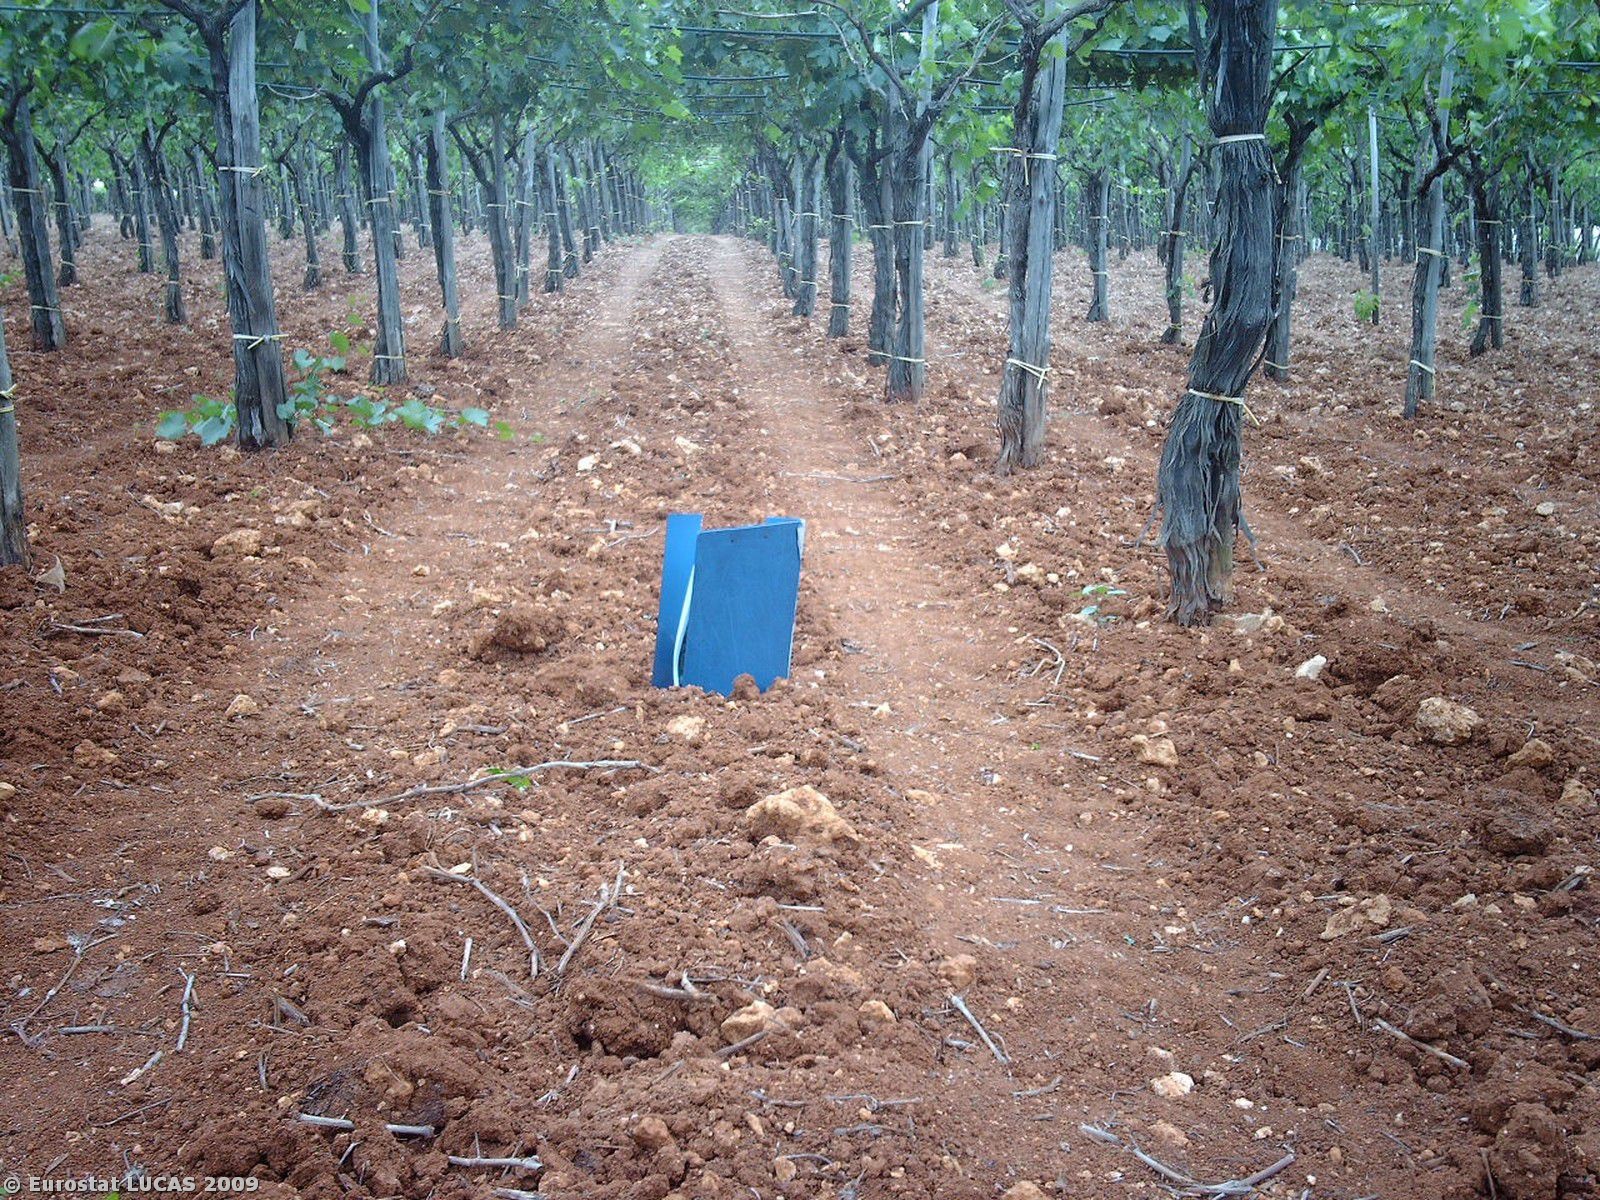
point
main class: Cropland
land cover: Vineyards
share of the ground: > 75 %
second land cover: Bare land
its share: 50 - 75 %
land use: Agriculture (excluding fallow land and kitchen gardens)
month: June
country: IT
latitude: 40.9430
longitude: 16.9984
